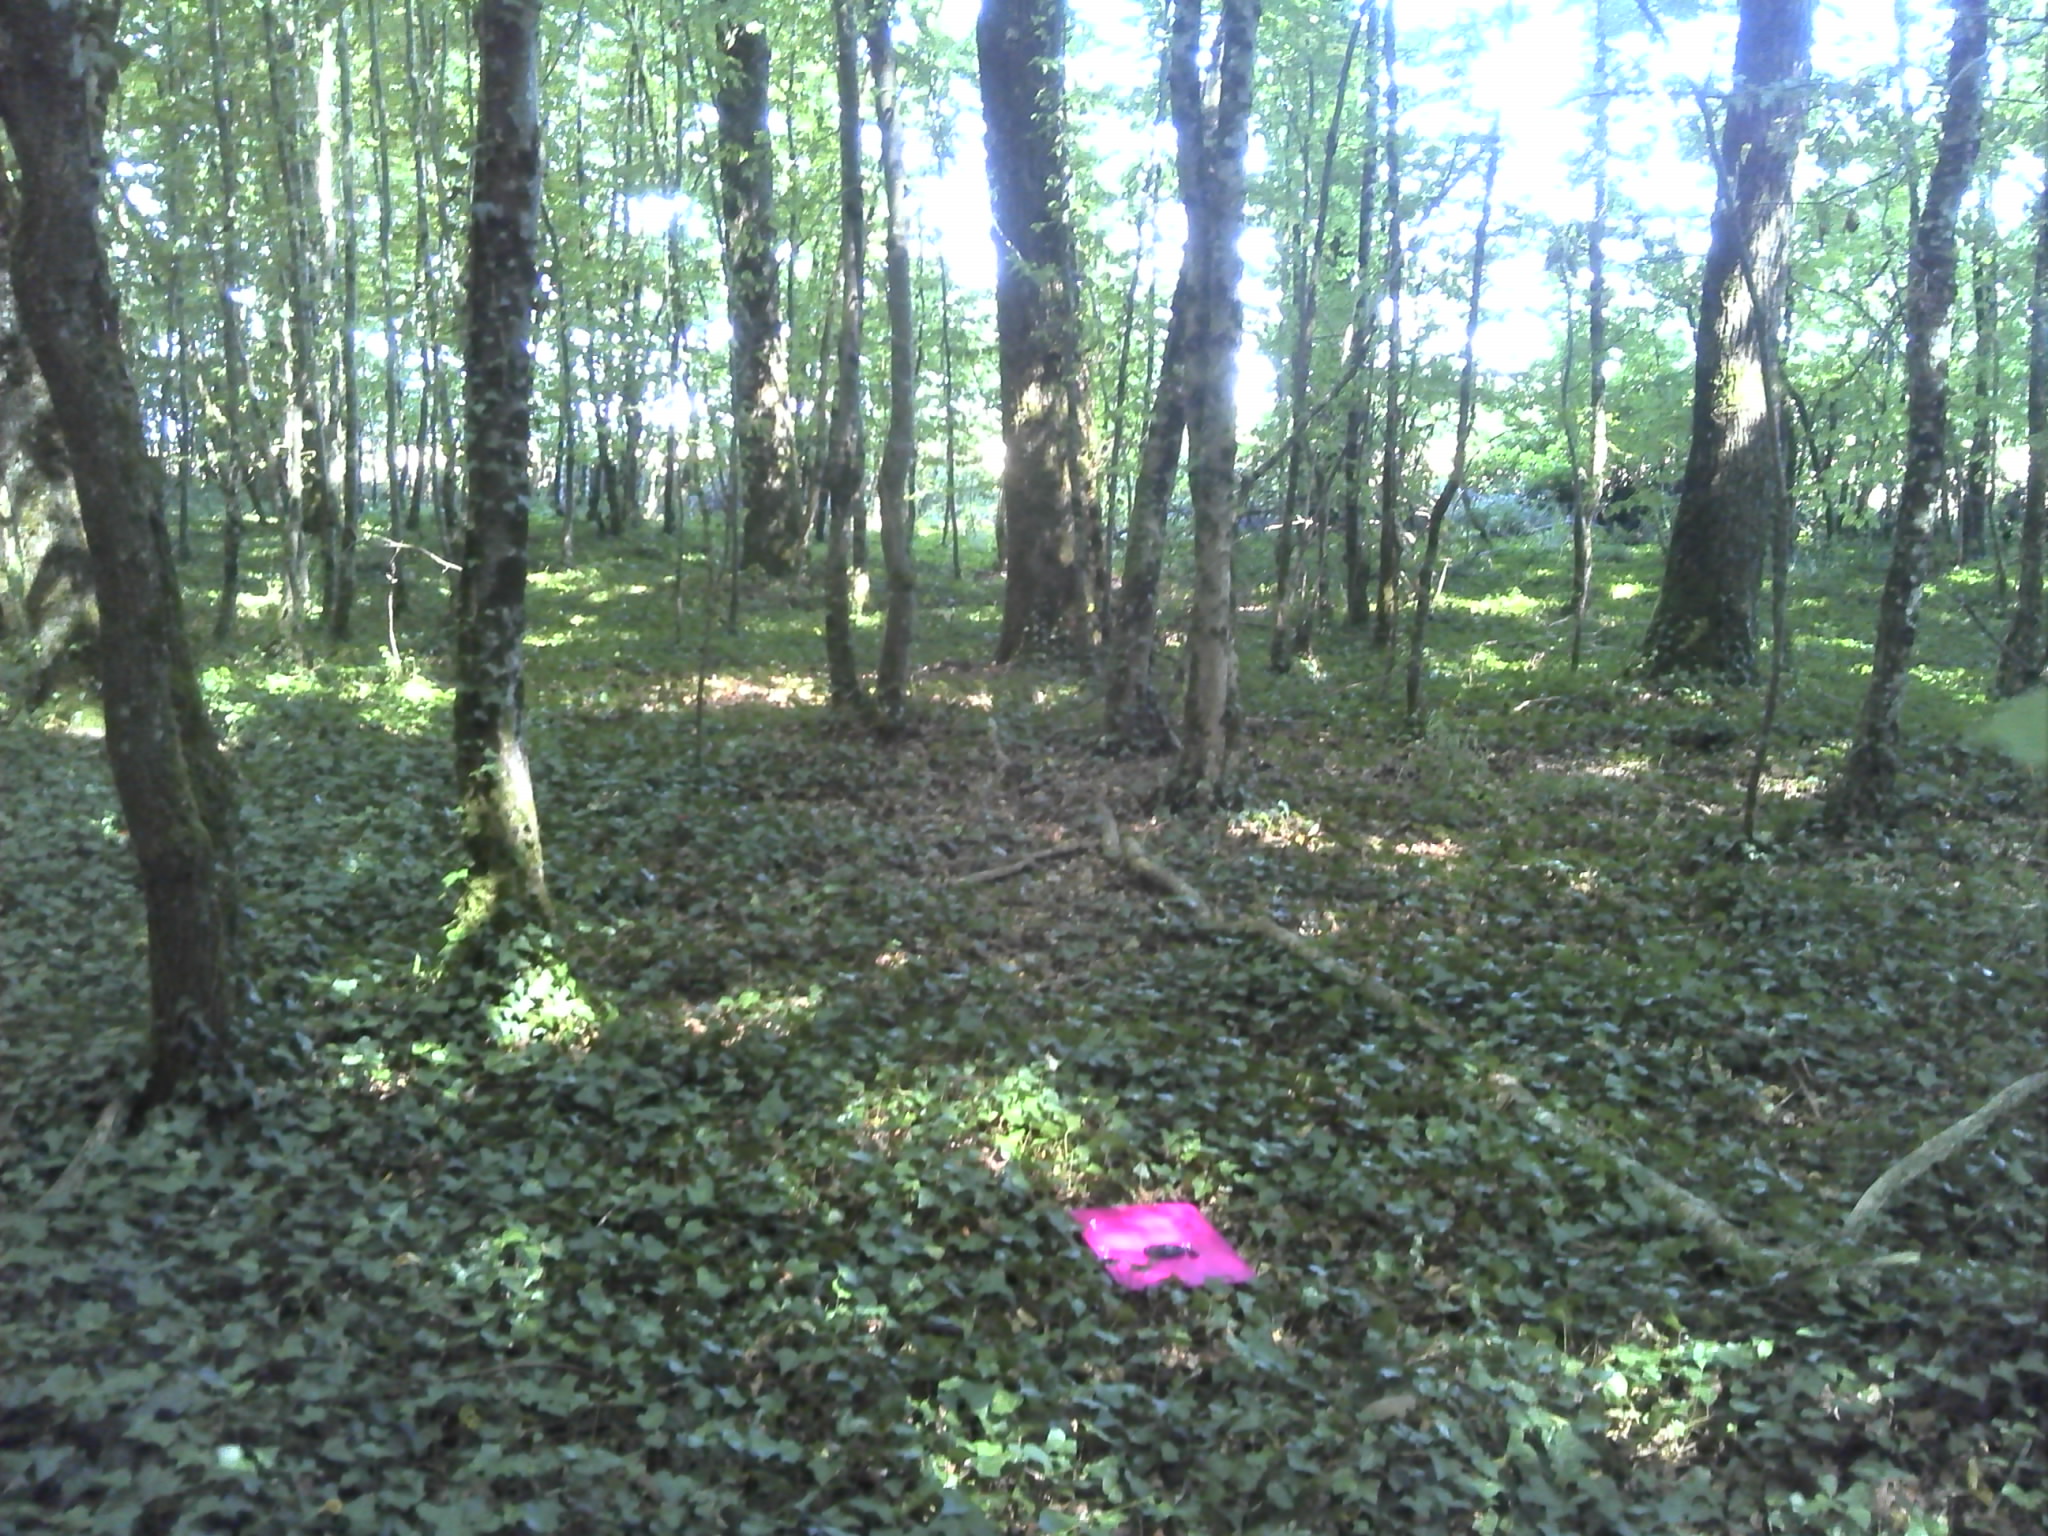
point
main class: Woodland
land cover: Broadleaved woodland
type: mesophytic deciduous forest
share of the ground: > 75 %
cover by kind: broadleaved forest trees 70 %, herbaceous plants 30 %
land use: Forestry
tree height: > 5 m
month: August
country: FR
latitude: 46.8675
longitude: 1.5533
